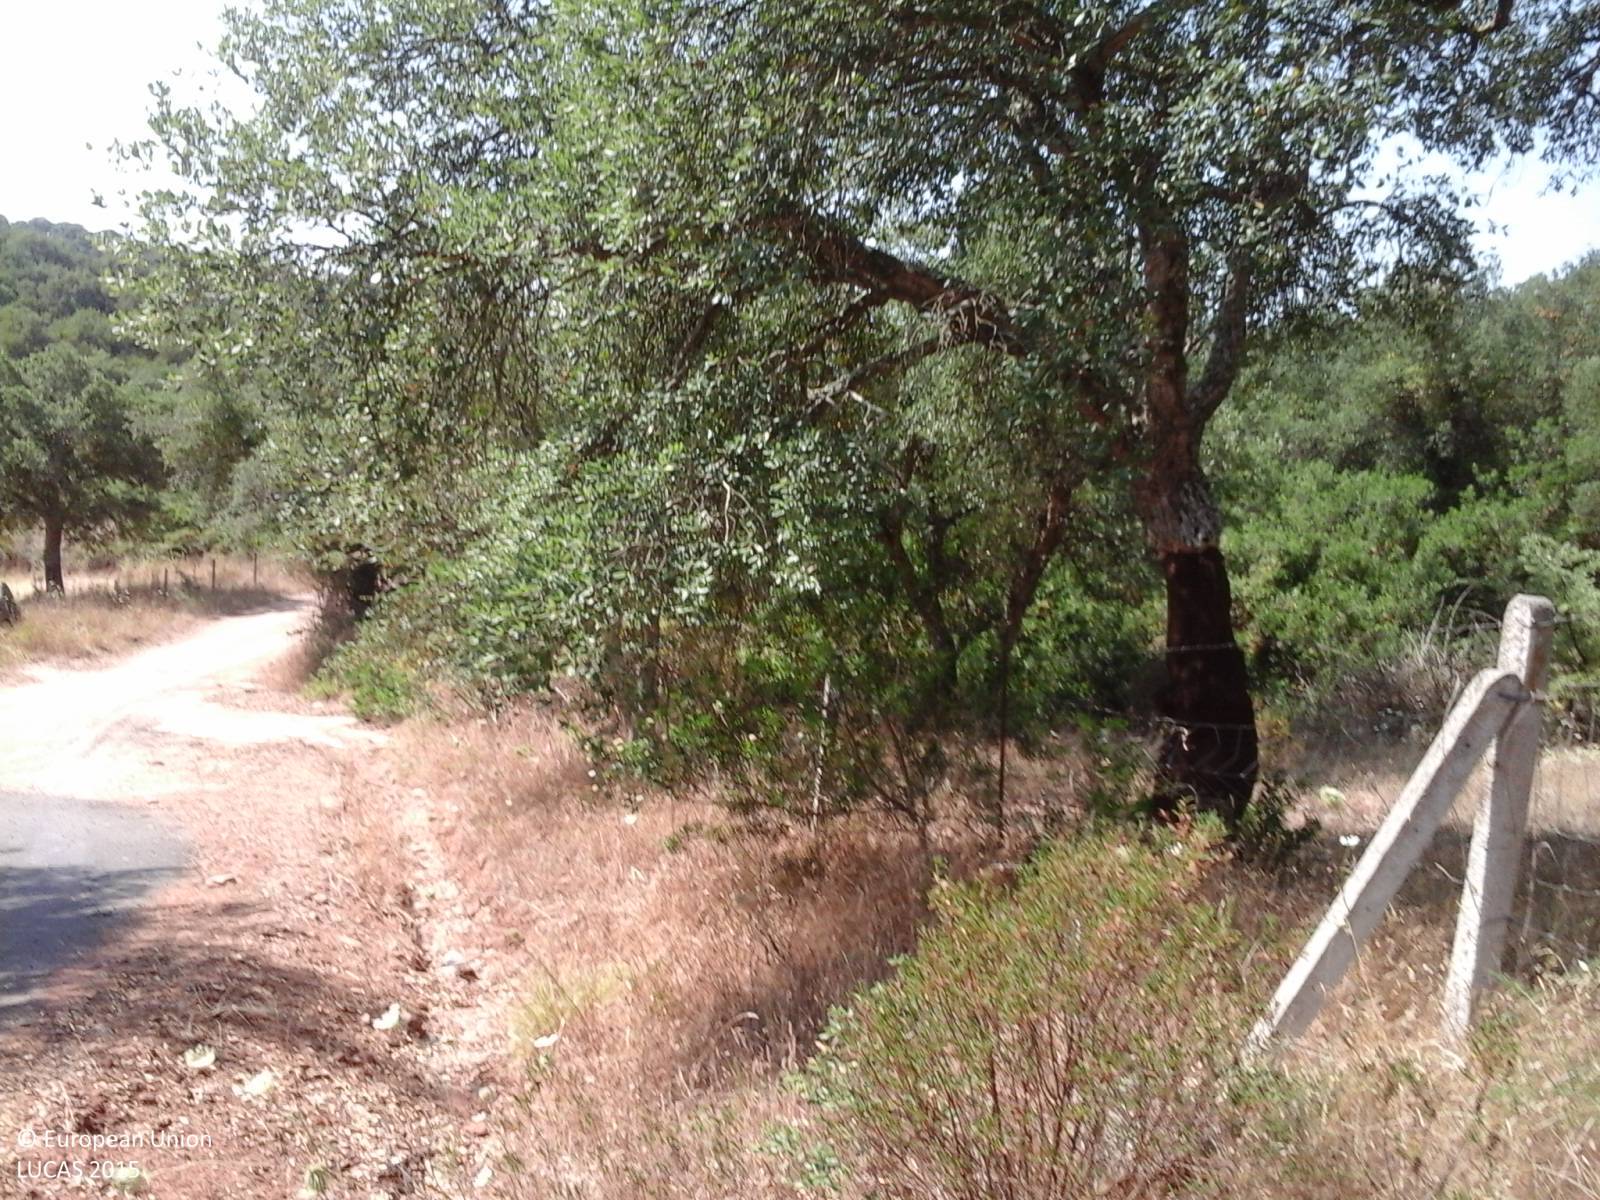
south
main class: Woodland
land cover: Broadleaved woodland
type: broadleaved evergreen forest
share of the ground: > 75 %
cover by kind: broadleaved forest trees 100 %
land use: Forestry
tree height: < 5 m
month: July
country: IT
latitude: 39.9349
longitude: 8.8711
